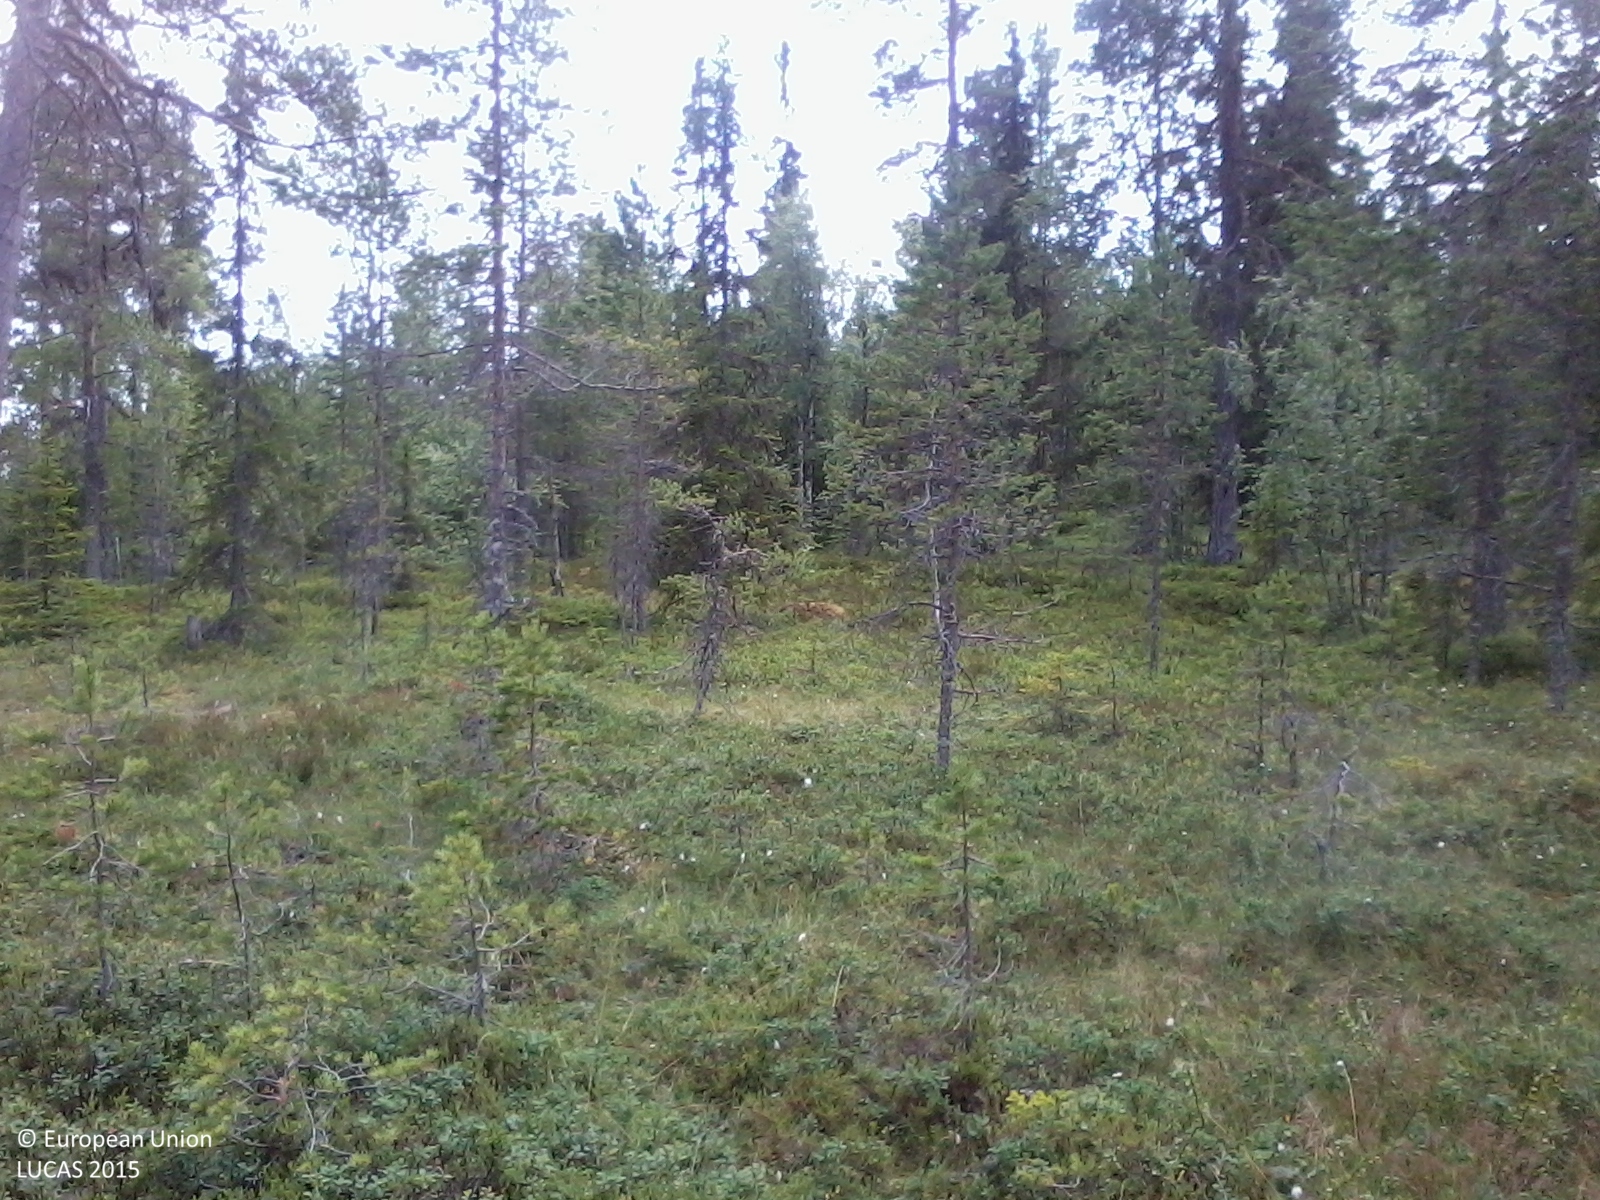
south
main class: Woodland
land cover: Pine dominated coniferous woodland
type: boreal forest
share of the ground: 10 - 25 %
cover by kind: shrubs 60 %, coniferous forest trees 20 %, herbaceous plants 15 %, lichens and mosses 5 %
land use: Forestry
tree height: > 5 m
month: August
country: SE
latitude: 62.8789
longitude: 17.1148
